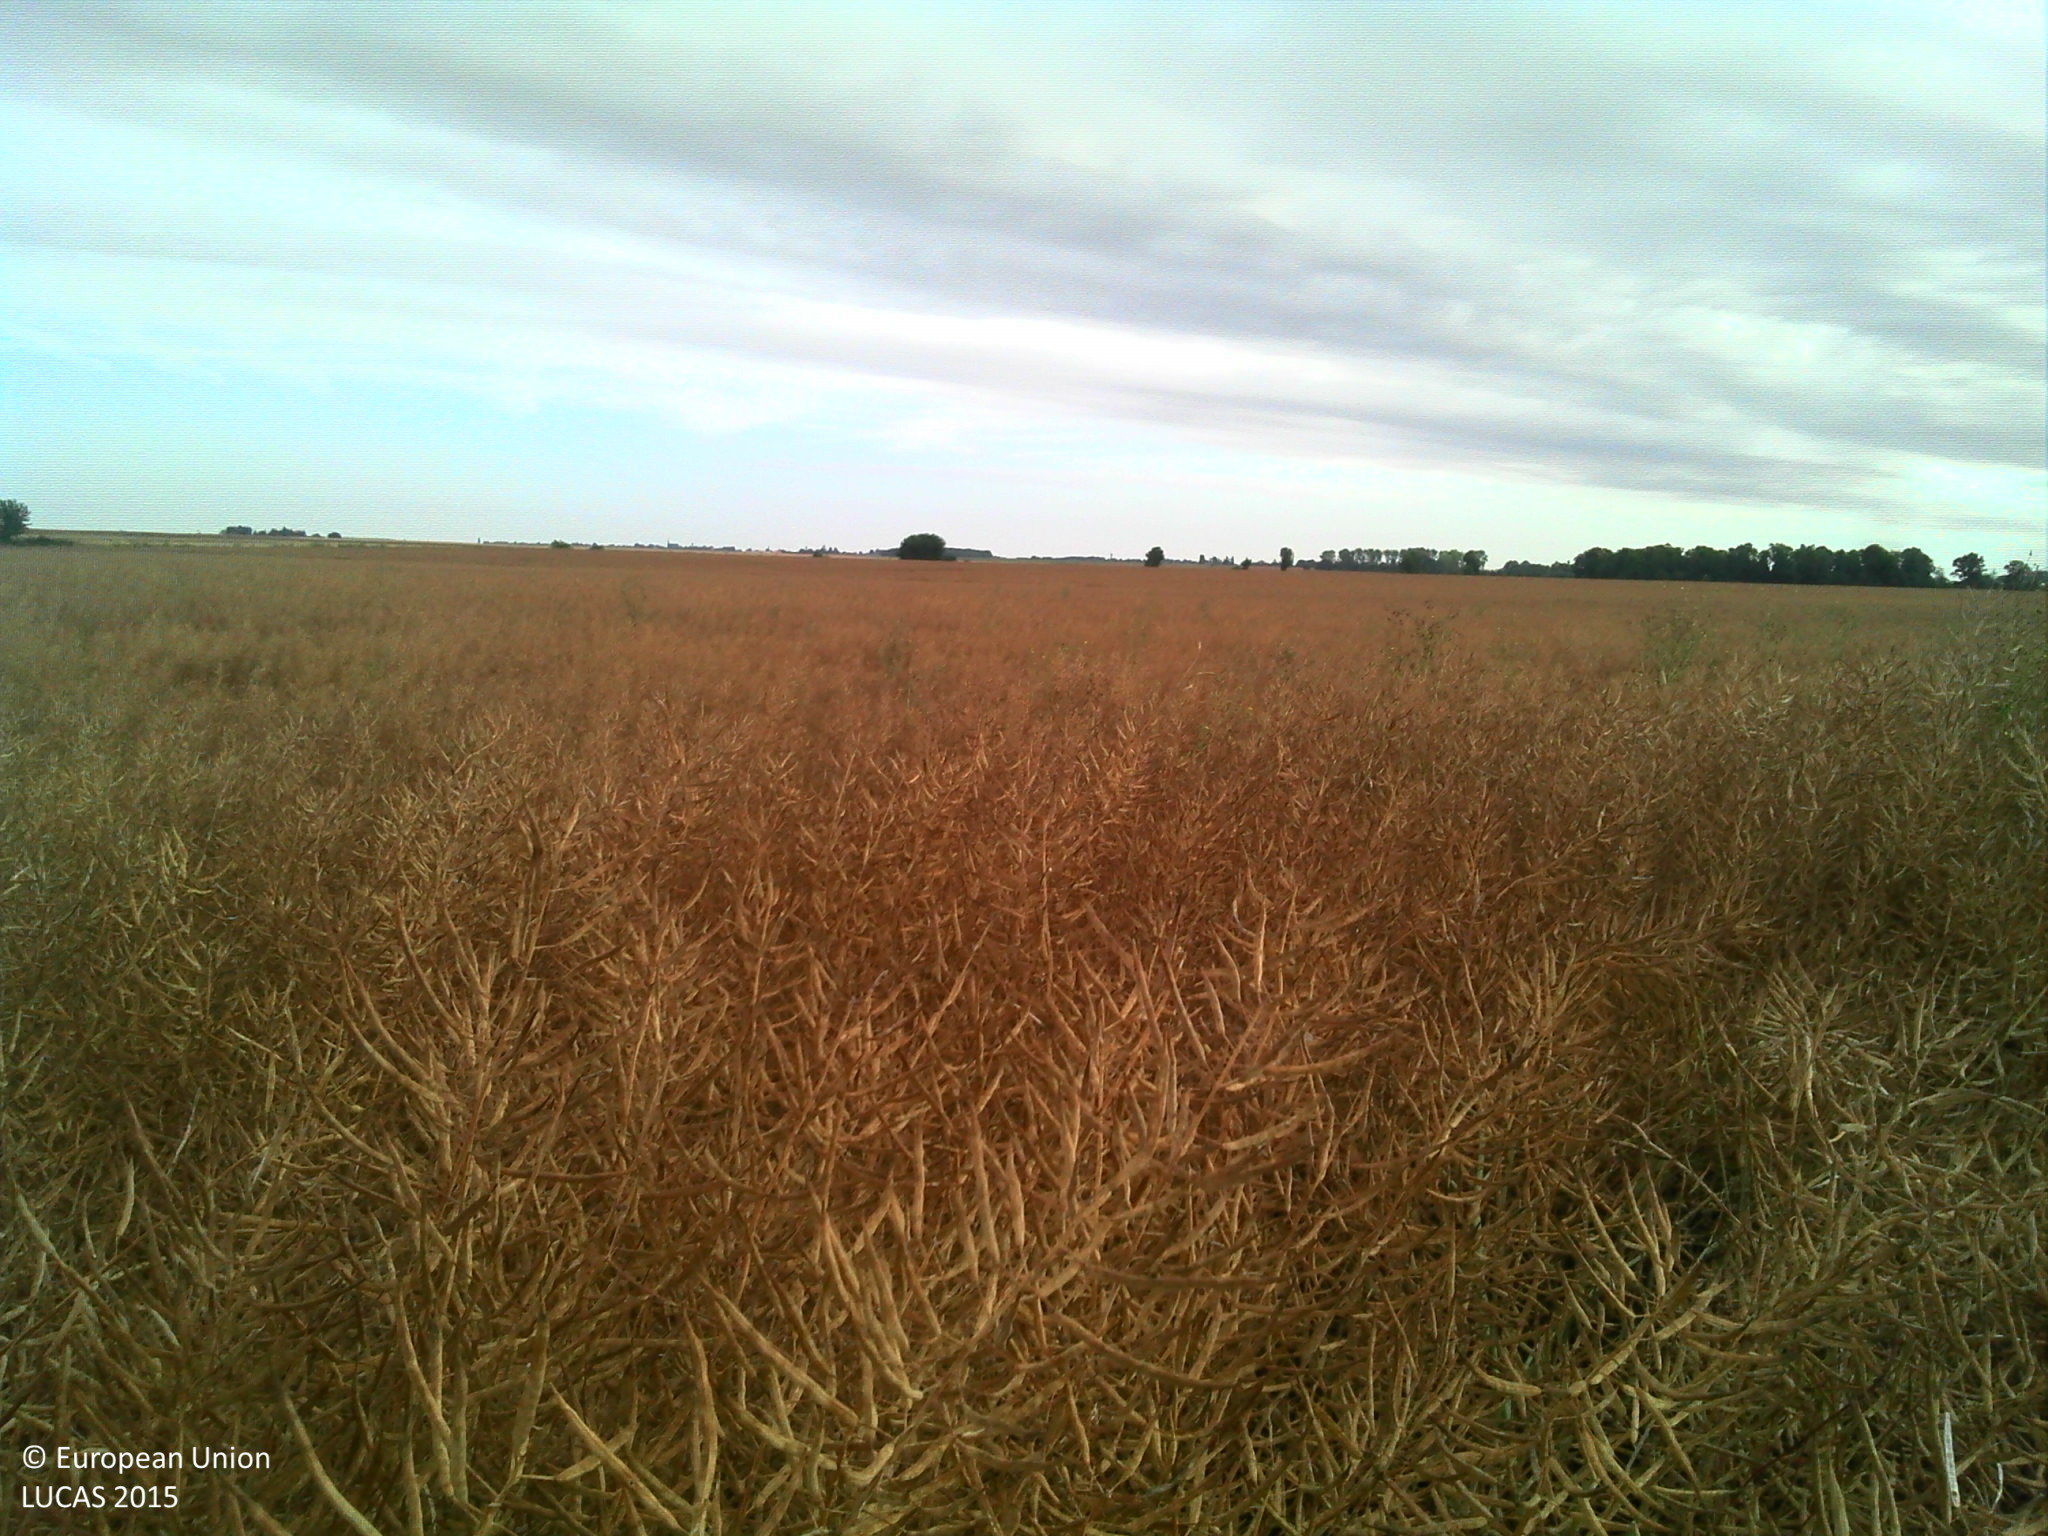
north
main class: Cropland
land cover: Rape and turnip rape
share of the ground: > 75 %
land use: Agriculture (excluding fallow land and kitchen gardens)
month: July
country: FR
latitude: 48.3101
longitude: 1.2581
